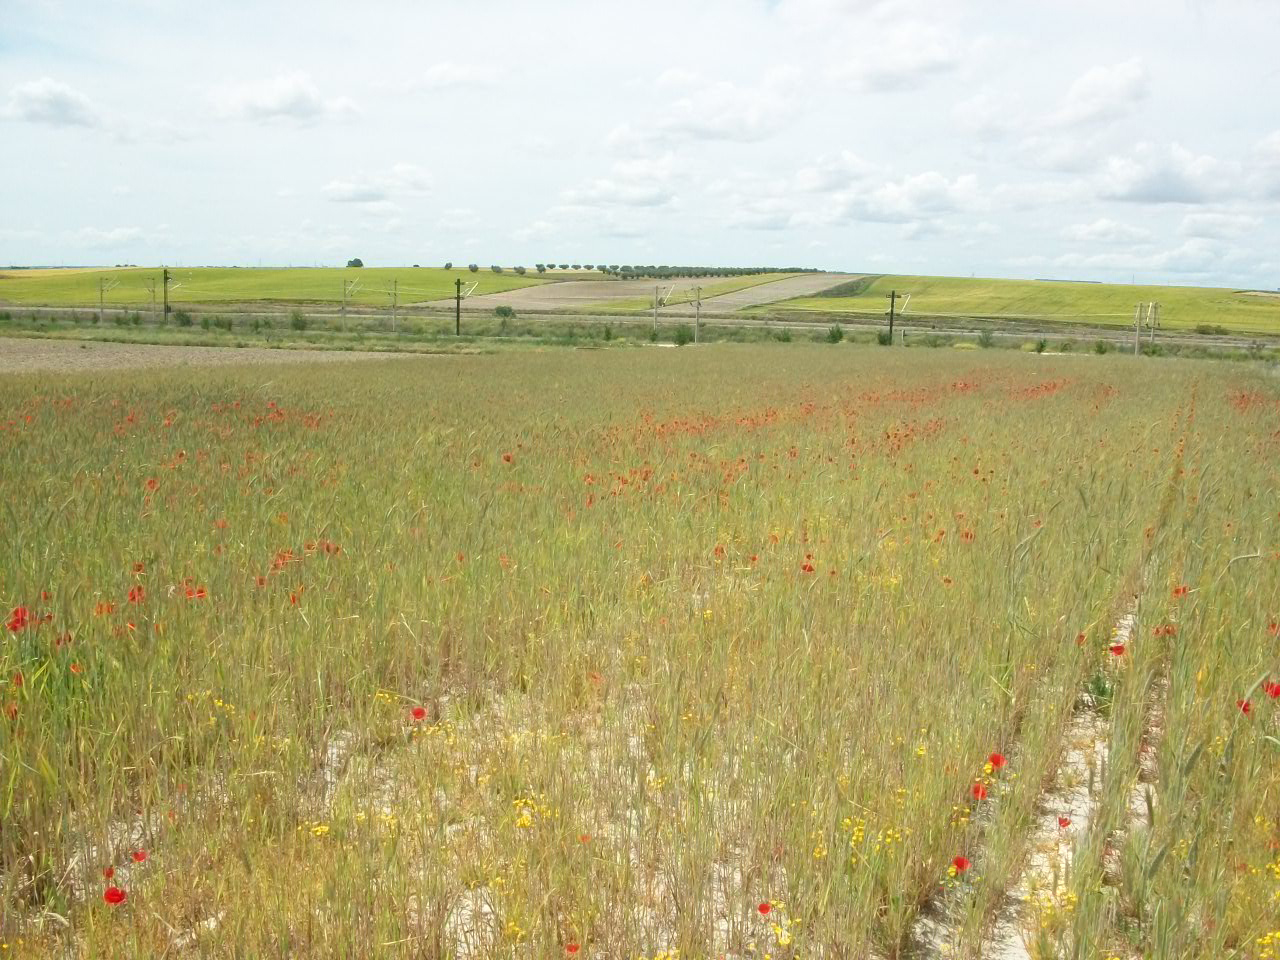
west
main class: Cropland
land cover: Mixed cereals for fodder
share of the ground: > 75 %
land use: Agriculture (excluding fallow land and kitchen gardens)
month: May
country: ES
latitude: 40.1541
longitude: -3.7585
